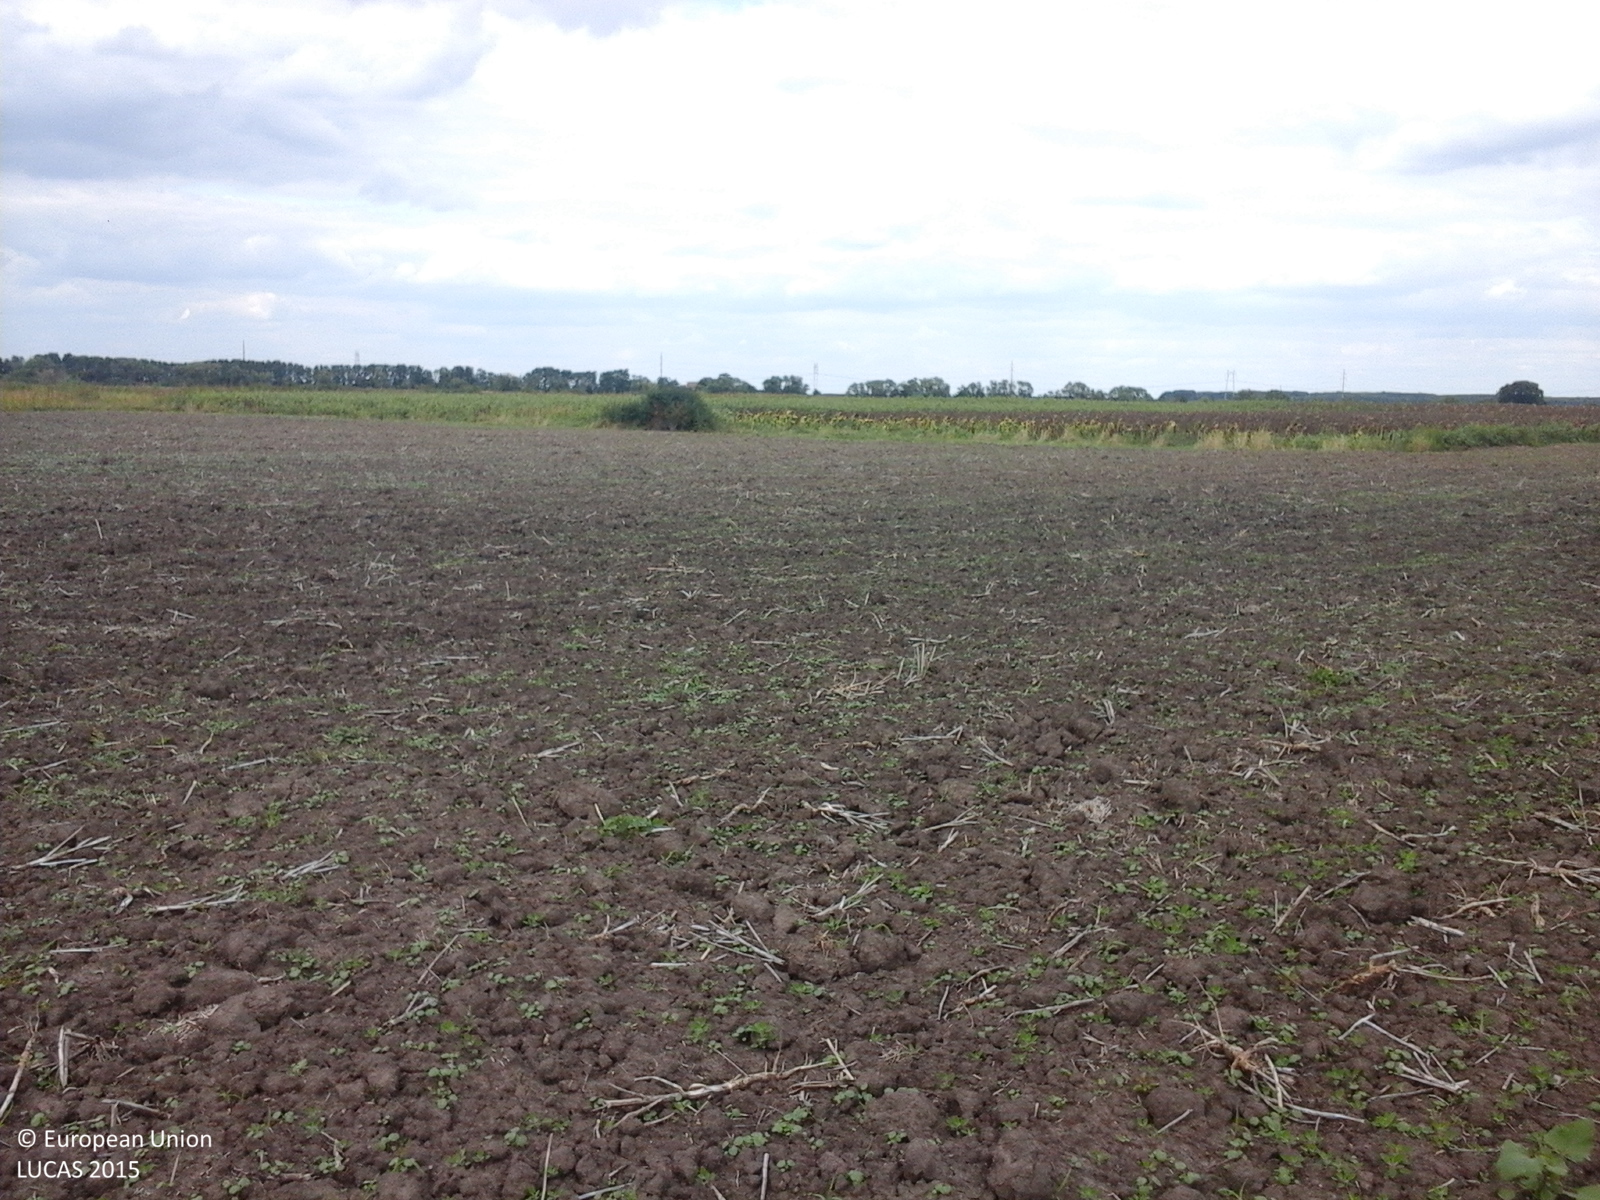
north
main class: Cropland
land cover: Rape and turnip rape
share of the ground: < 10 %
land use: Agriculture (excluding fallow land and kitchen gardens)
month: September
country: RO
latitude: 47.5084
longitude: 22.6597
